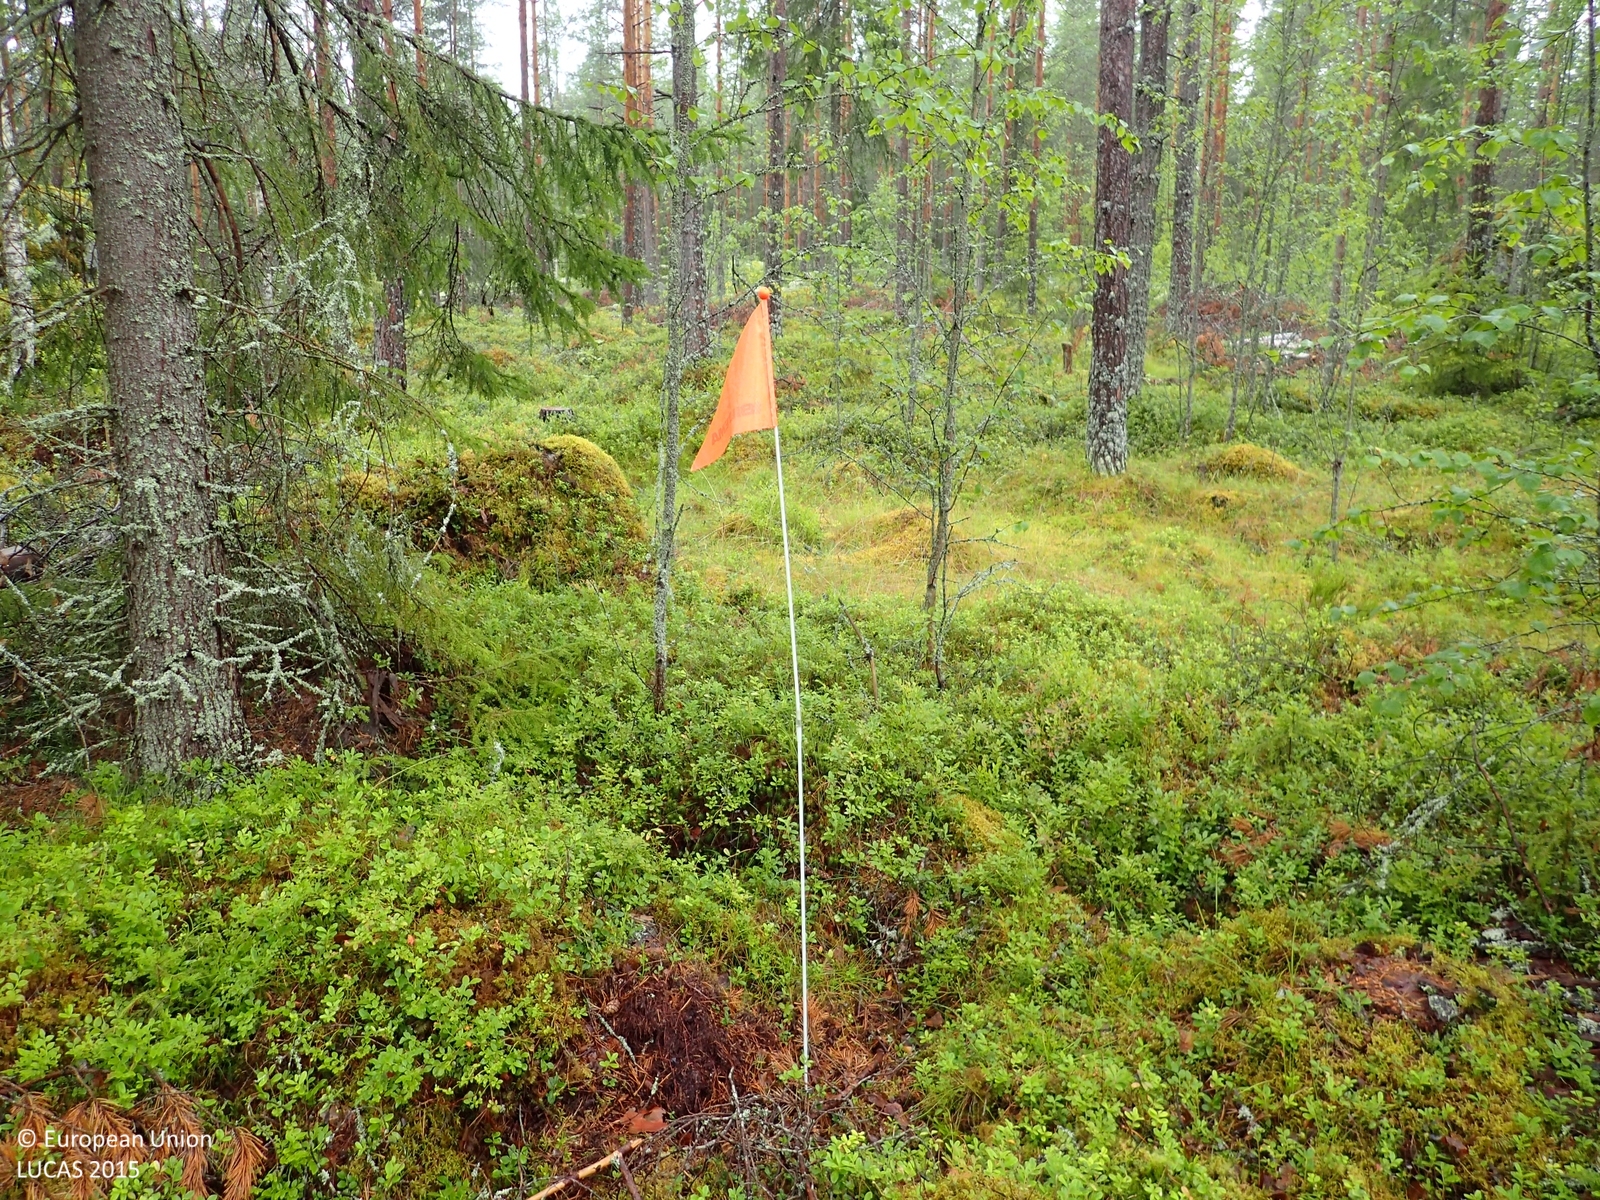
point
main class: Woodland
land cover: Pine dominated coniferous woodland
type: boreal forest
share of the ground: 50 - 75 %
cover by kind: coniferous forest trees 45 %, shrubs 40 %, broadleaved forest trees 10 %, lichens and mosses 5 %
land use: Forestry
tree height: > 5 m
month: July
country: FI
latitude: 63.0193
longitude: 22.7585
